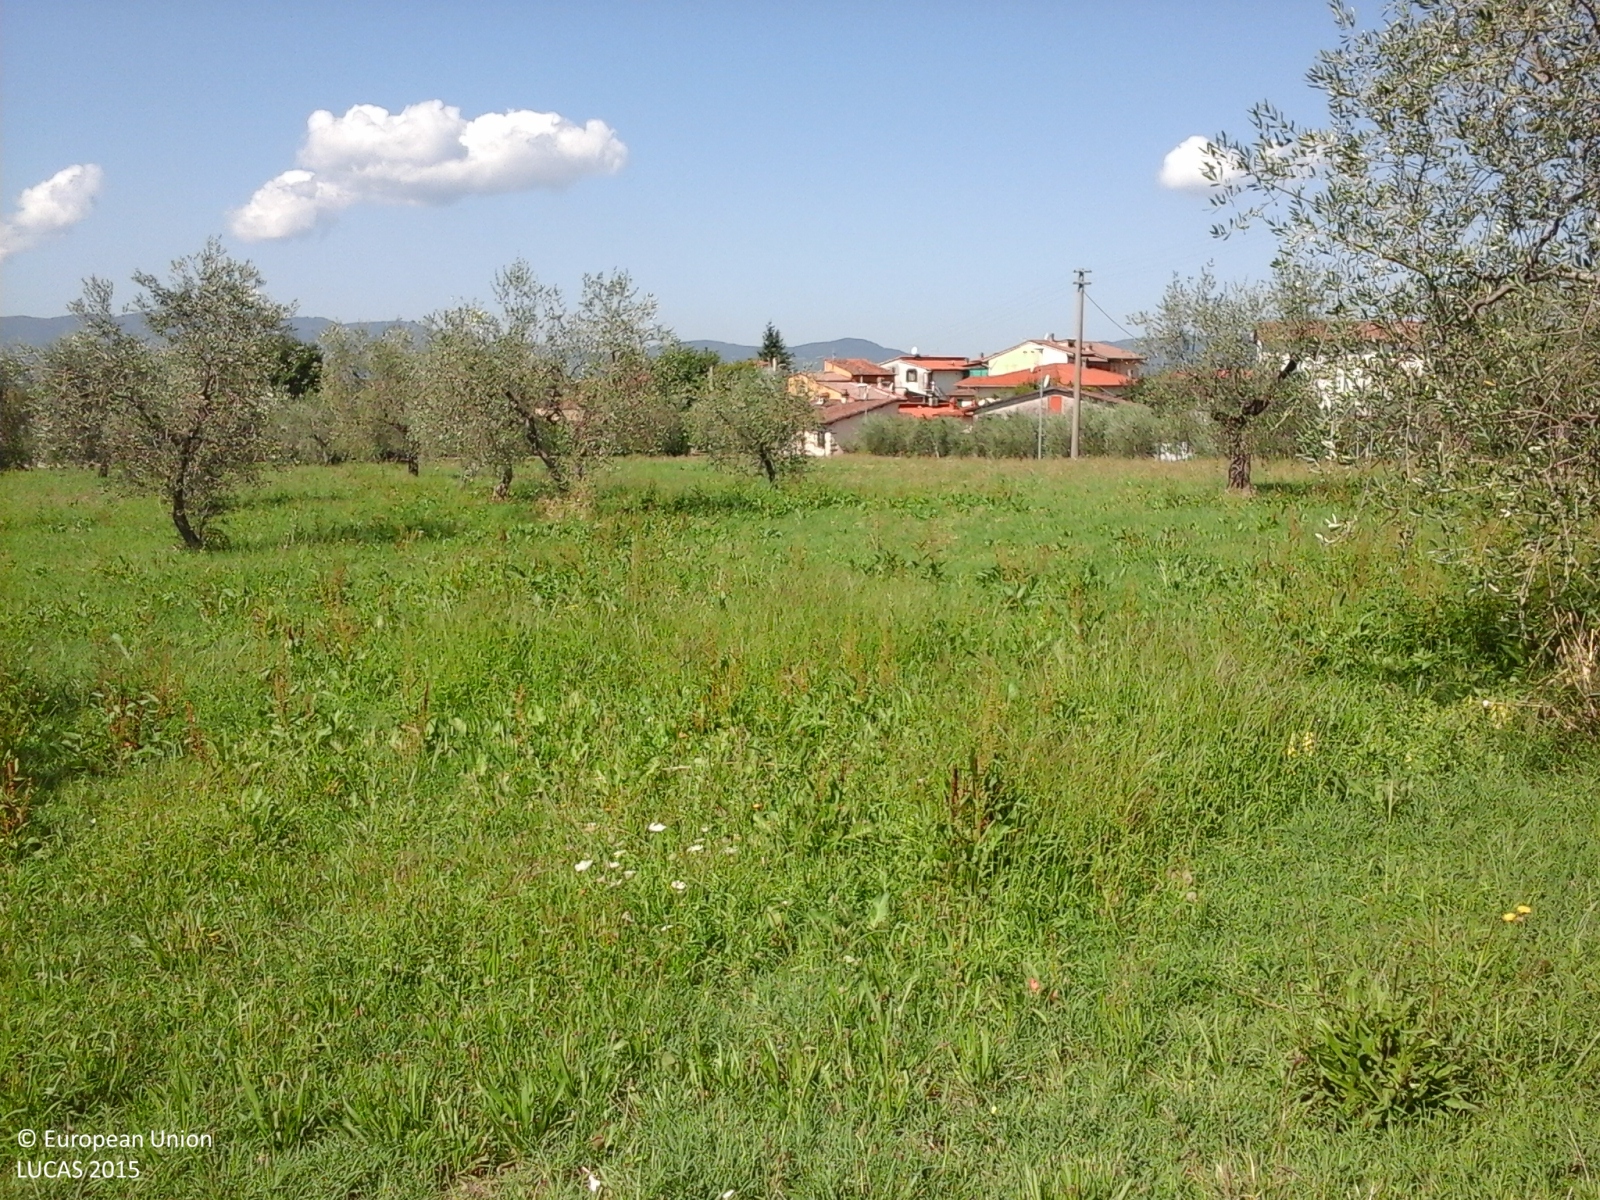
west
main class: Cropland
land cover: Olive groves
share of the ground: < 10 %
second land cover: Grassland without tree/shrub cover
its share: > 75 %
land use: Agriculture (excluding fallow land and kitchen gardens)
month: August
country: IT
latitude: 43.6718
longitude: 11.5215
